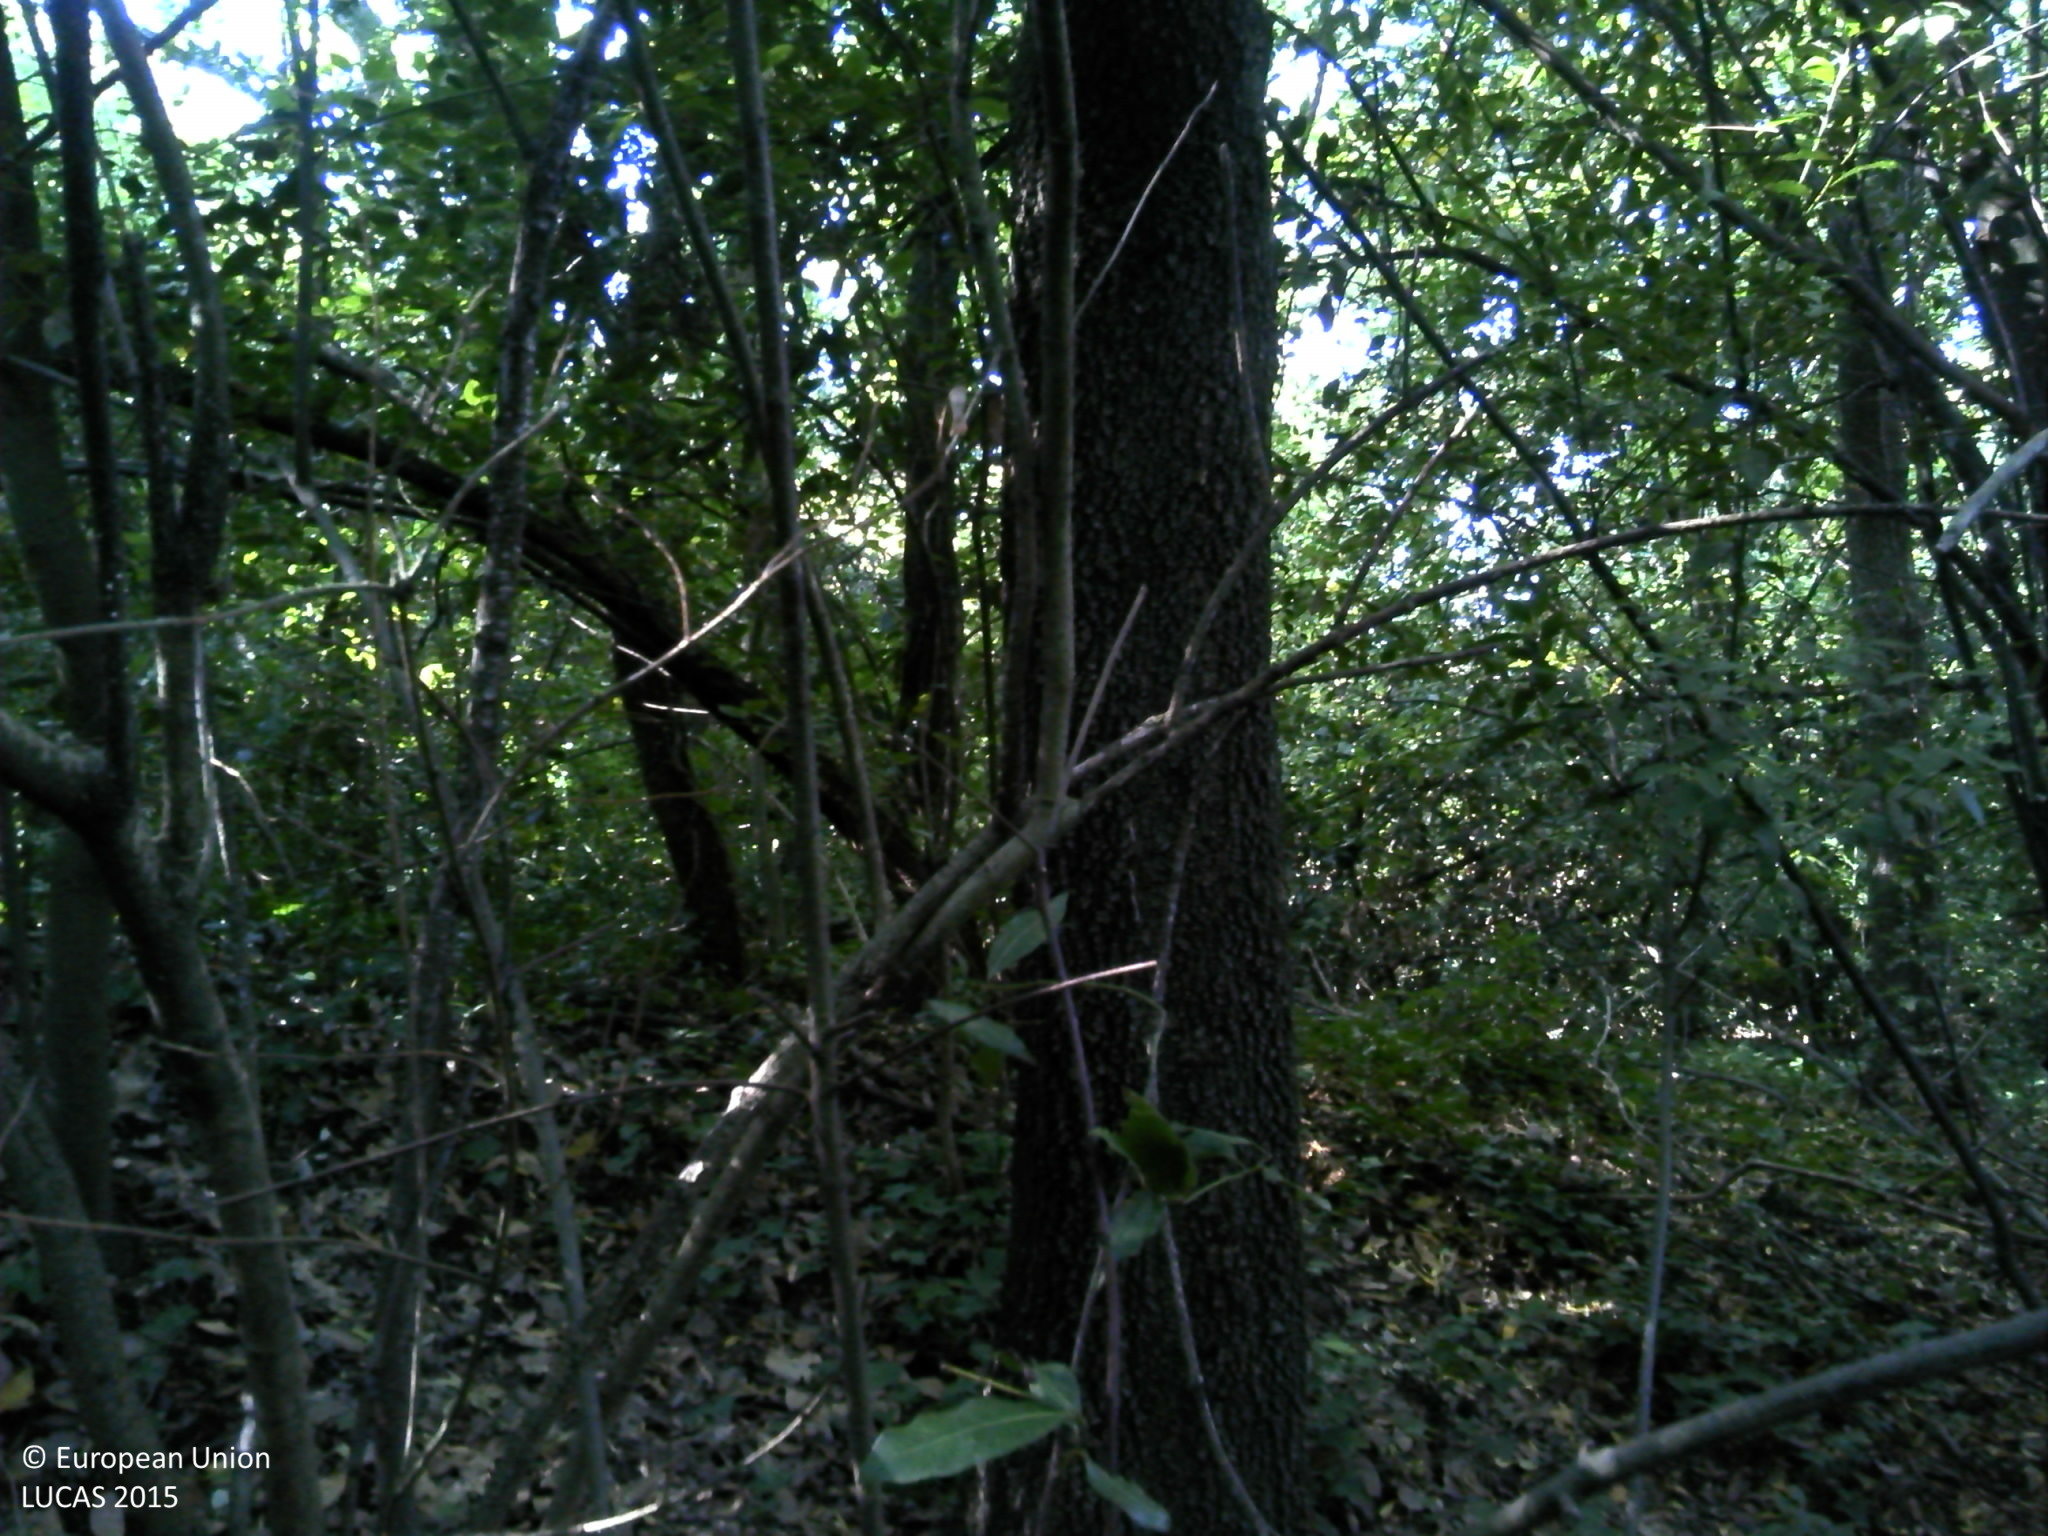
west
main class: Woodland
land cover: Broadleaved woodland
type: broadleaved evergreen forest
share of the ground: > 75 %
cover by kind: broadleaved forest trees 80 %, herbaceous plants 10 %, unconsolidated bare surface 10 %
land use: Semi-natural and natural areas not in use
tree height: > 5 m
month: October
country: FR
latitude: 43.7644
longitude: 4.3819
